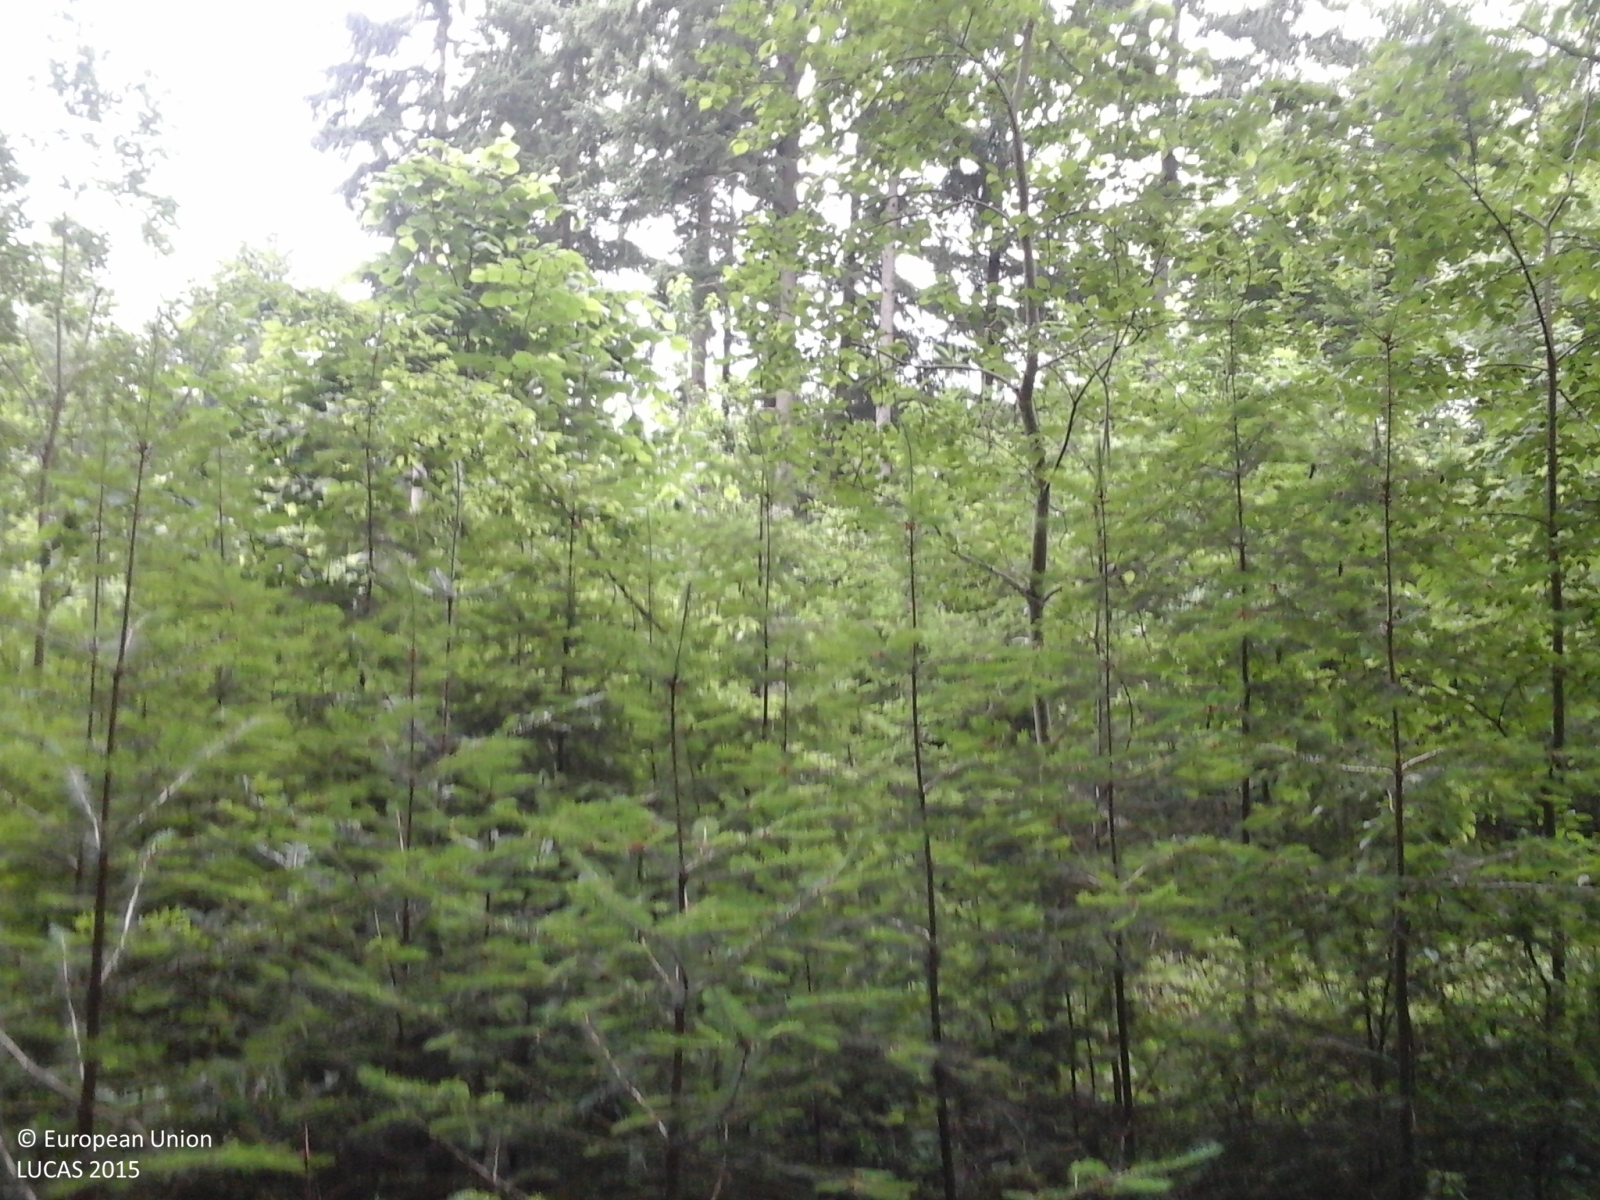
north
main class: Woodland
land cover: Other coniferous woodland
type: alpine coniferous forest
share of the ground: > 75 %
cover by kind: coniferous forest trees 75 %, broadleaved forest trees 25 %
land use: Forestry
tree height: > 5 m
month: May
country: IT
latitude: 43.7793
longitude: 11.5739
